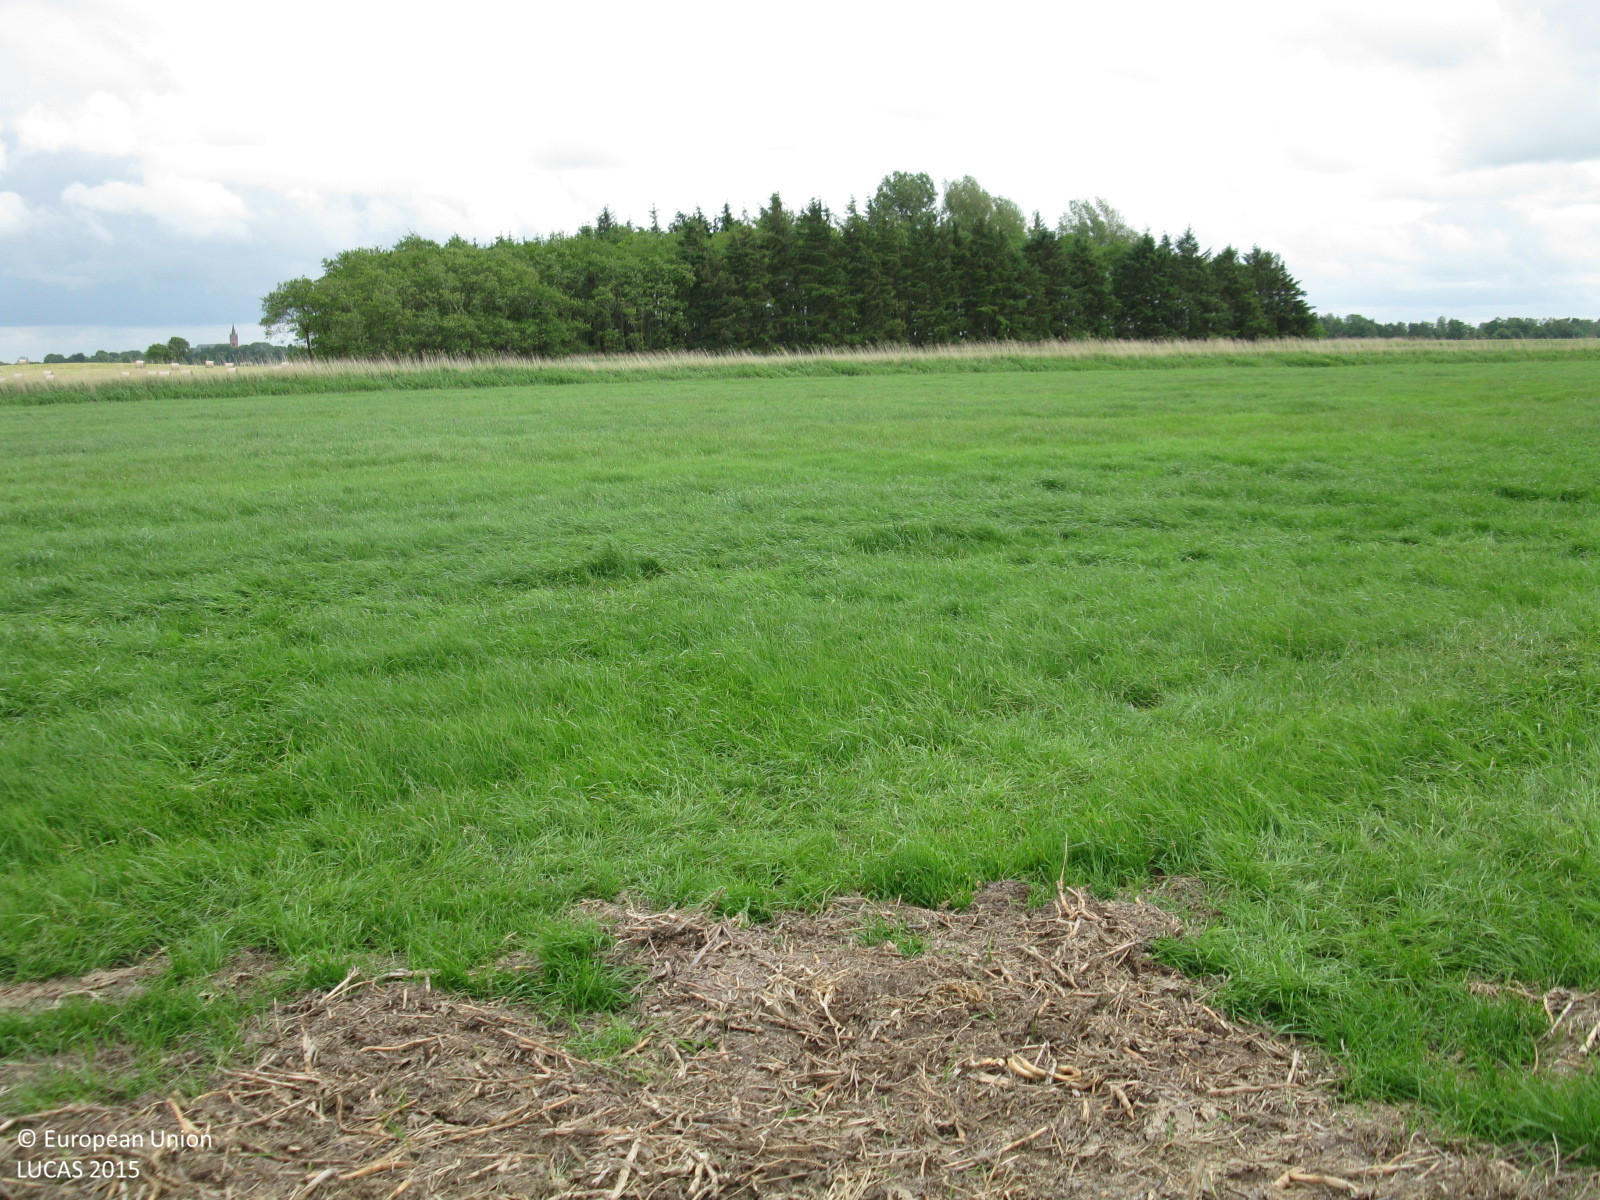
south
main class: Cropland
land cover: Temporary grasslands
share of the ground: > 75 %
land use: Agriculture (excluding fallow land and kitchen gardens)
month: June
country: DE
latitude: 53.6255
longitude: 7.3849
